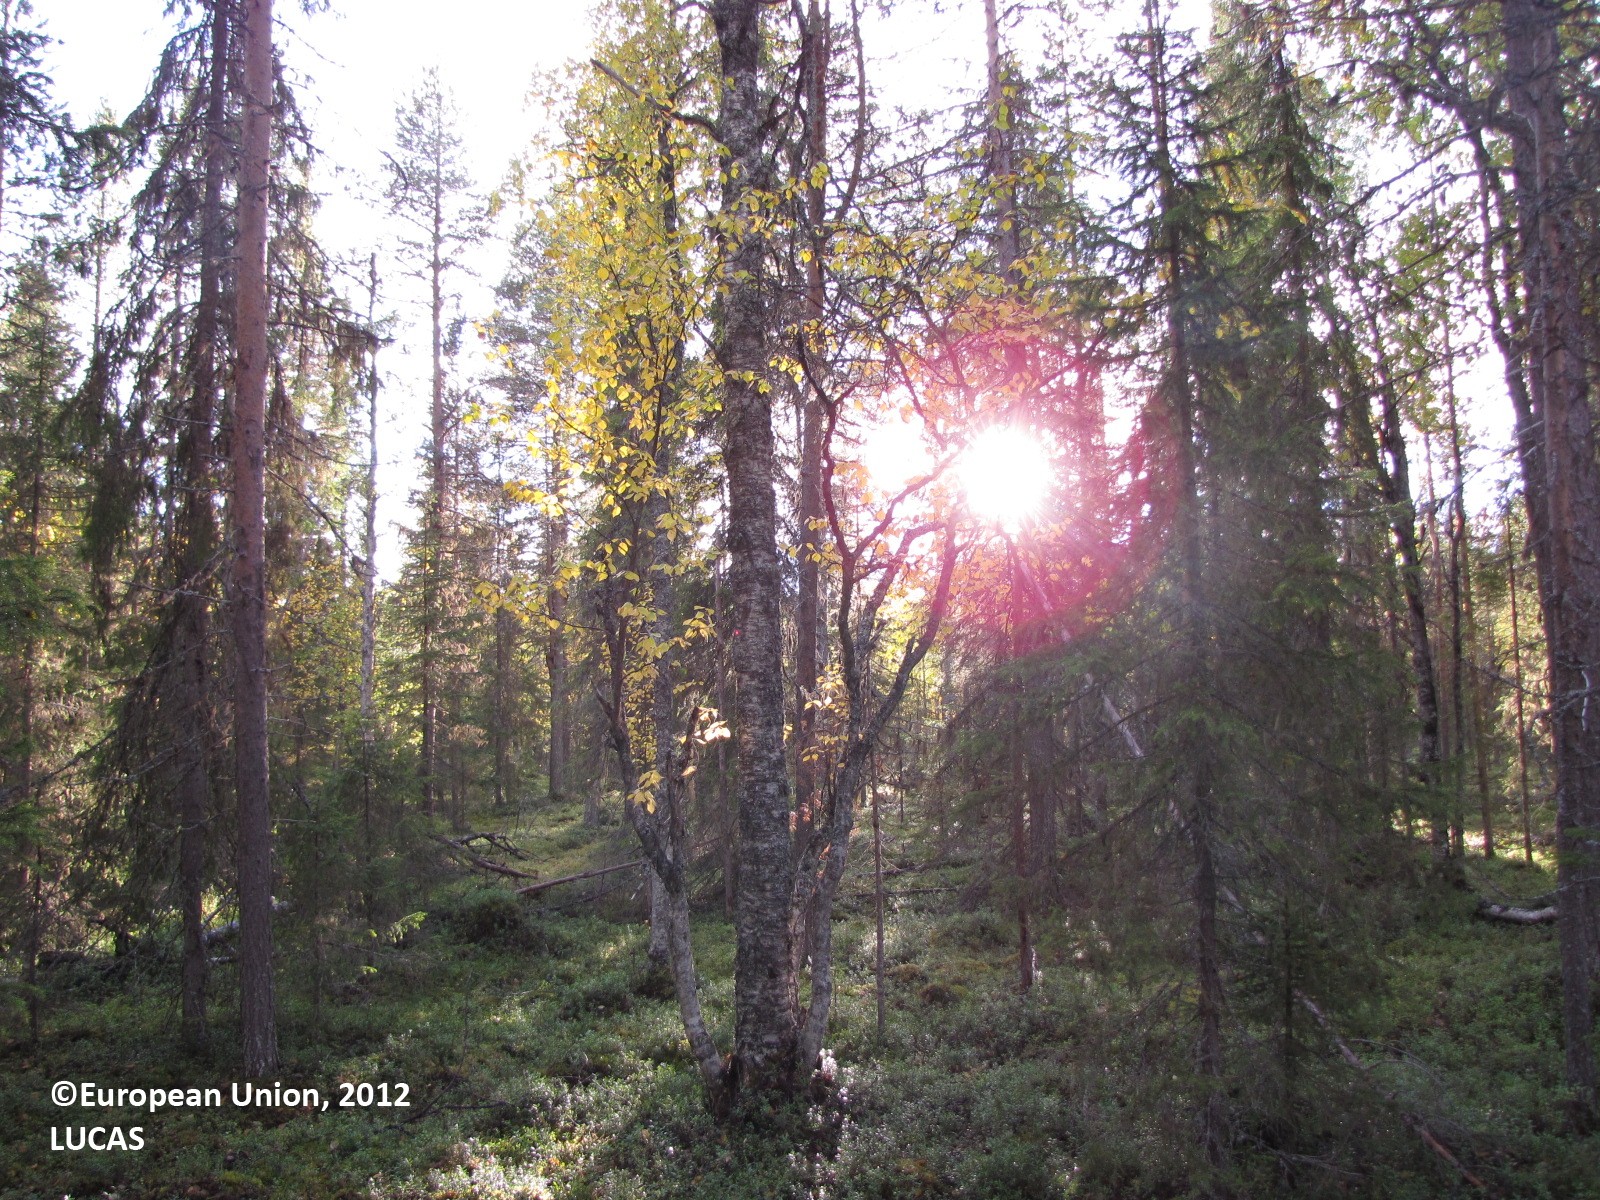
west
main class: Woodland
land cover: Other mixed woodland
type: boreal forest
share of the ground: 25 - 50 %
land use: Forestry
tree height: > 5 m
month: September
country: FI
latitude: 67.3314
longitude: 25.3243
